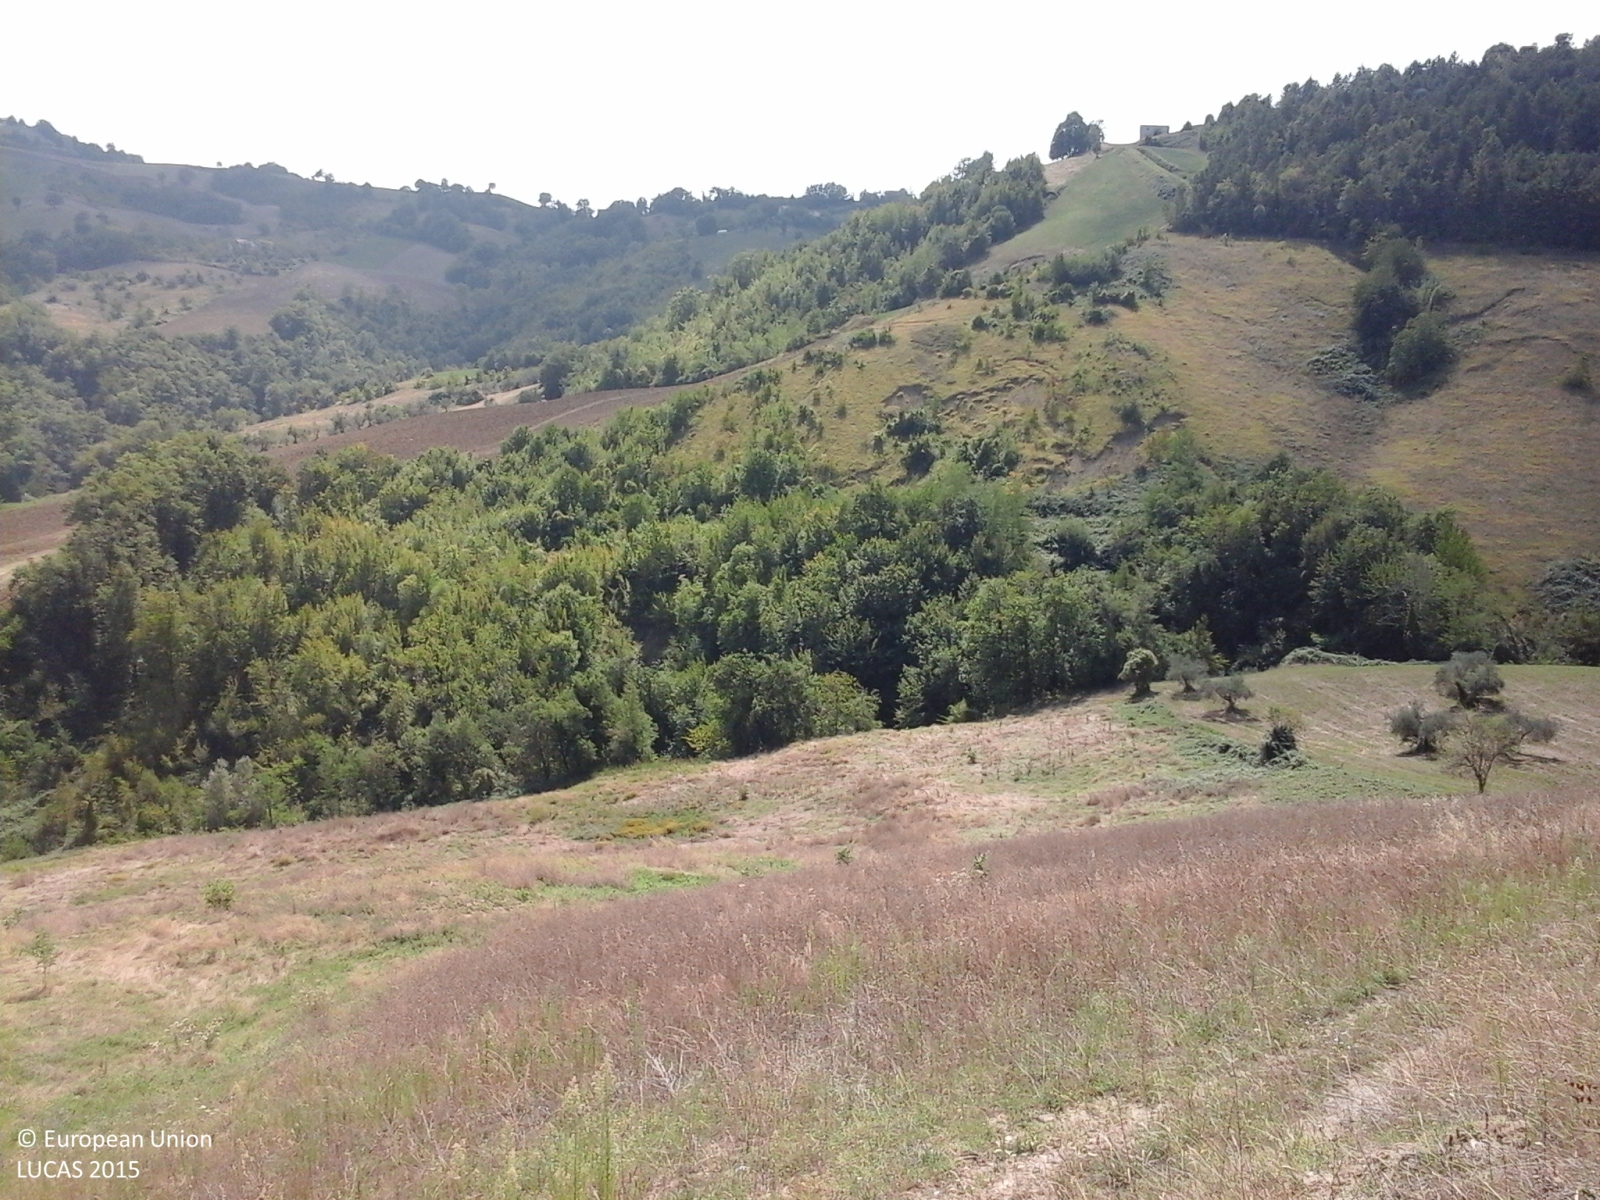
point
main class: Woodland
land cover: Broadleaved woodland
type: thermophilous deciduous forest
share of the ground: > 75 %
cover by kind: broadleaved forest trees 80 %, shrubs 10 %, herbaceous plants 10 %
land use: Semi-natural and natural areas not in use
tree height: > 5 m
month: September
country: IT
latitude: 42.5105
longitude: 13.7979
